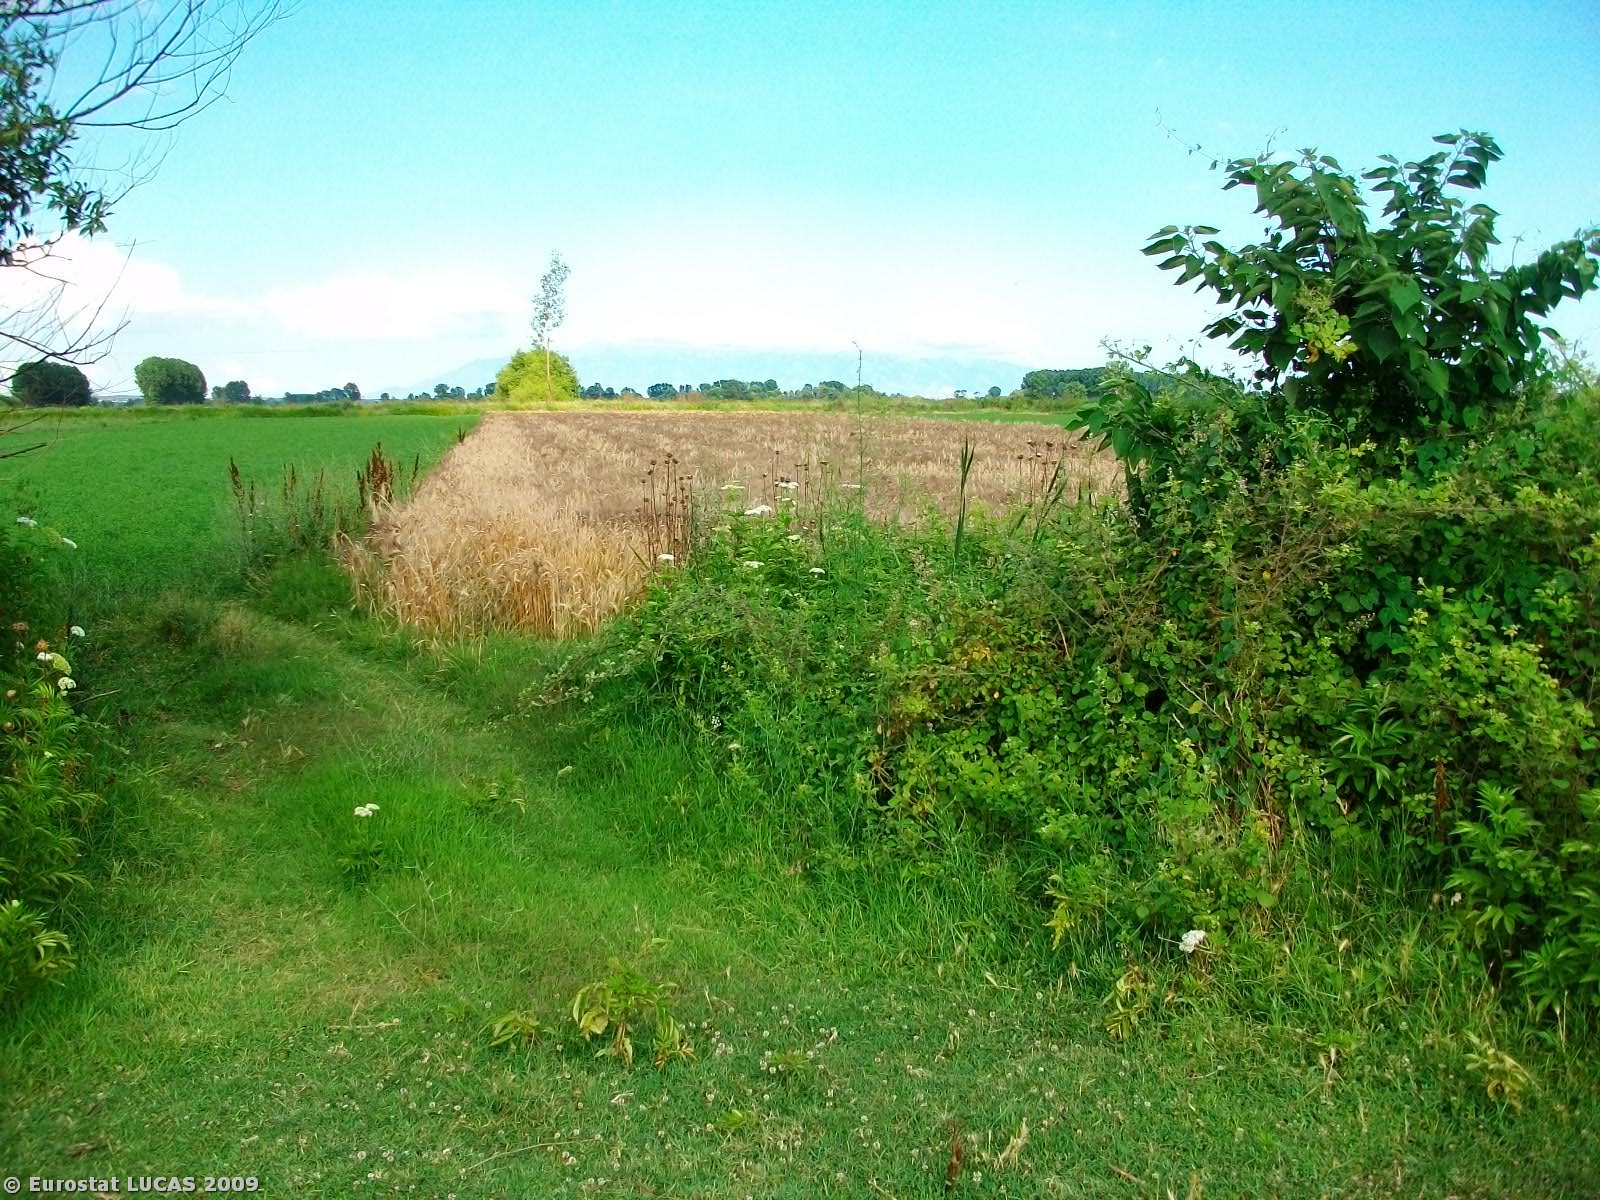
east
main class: Cropland
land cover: Durum wheat
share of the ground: > 75 %
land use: Agriculture (excluding fallow land and kitchen gardens)
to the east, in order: Durum wheat; Shruby margins; Ditches and canals; Shruby margins; Paved roads, cycling and walking lanes; Grass margins; Electric lines; Durum wheat; Maize
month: June
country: GR
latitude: 40.9812
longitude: 23.6042
